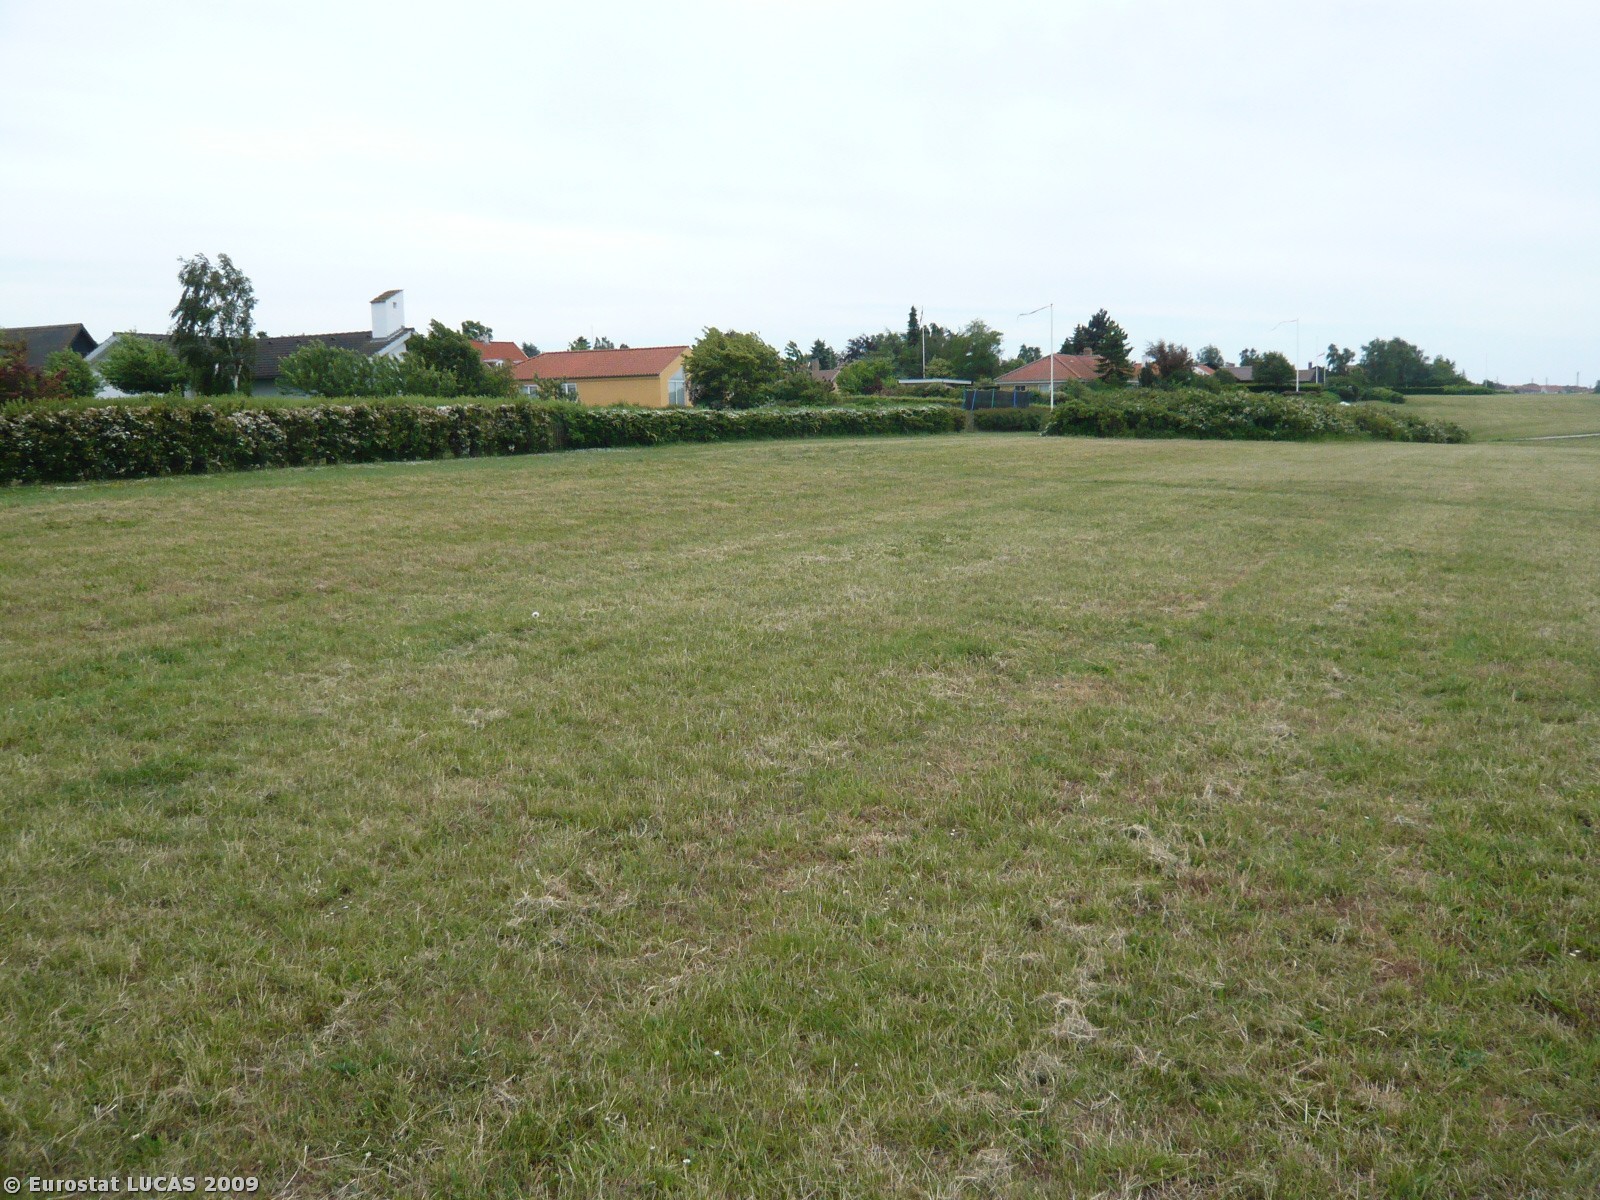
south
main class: Grassland
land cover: Grassland without tree/shrub cover
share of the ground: > 75 %
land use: Amenities, museums, leisure
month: June
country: DK
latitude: 55.2643
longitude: 11.3051
